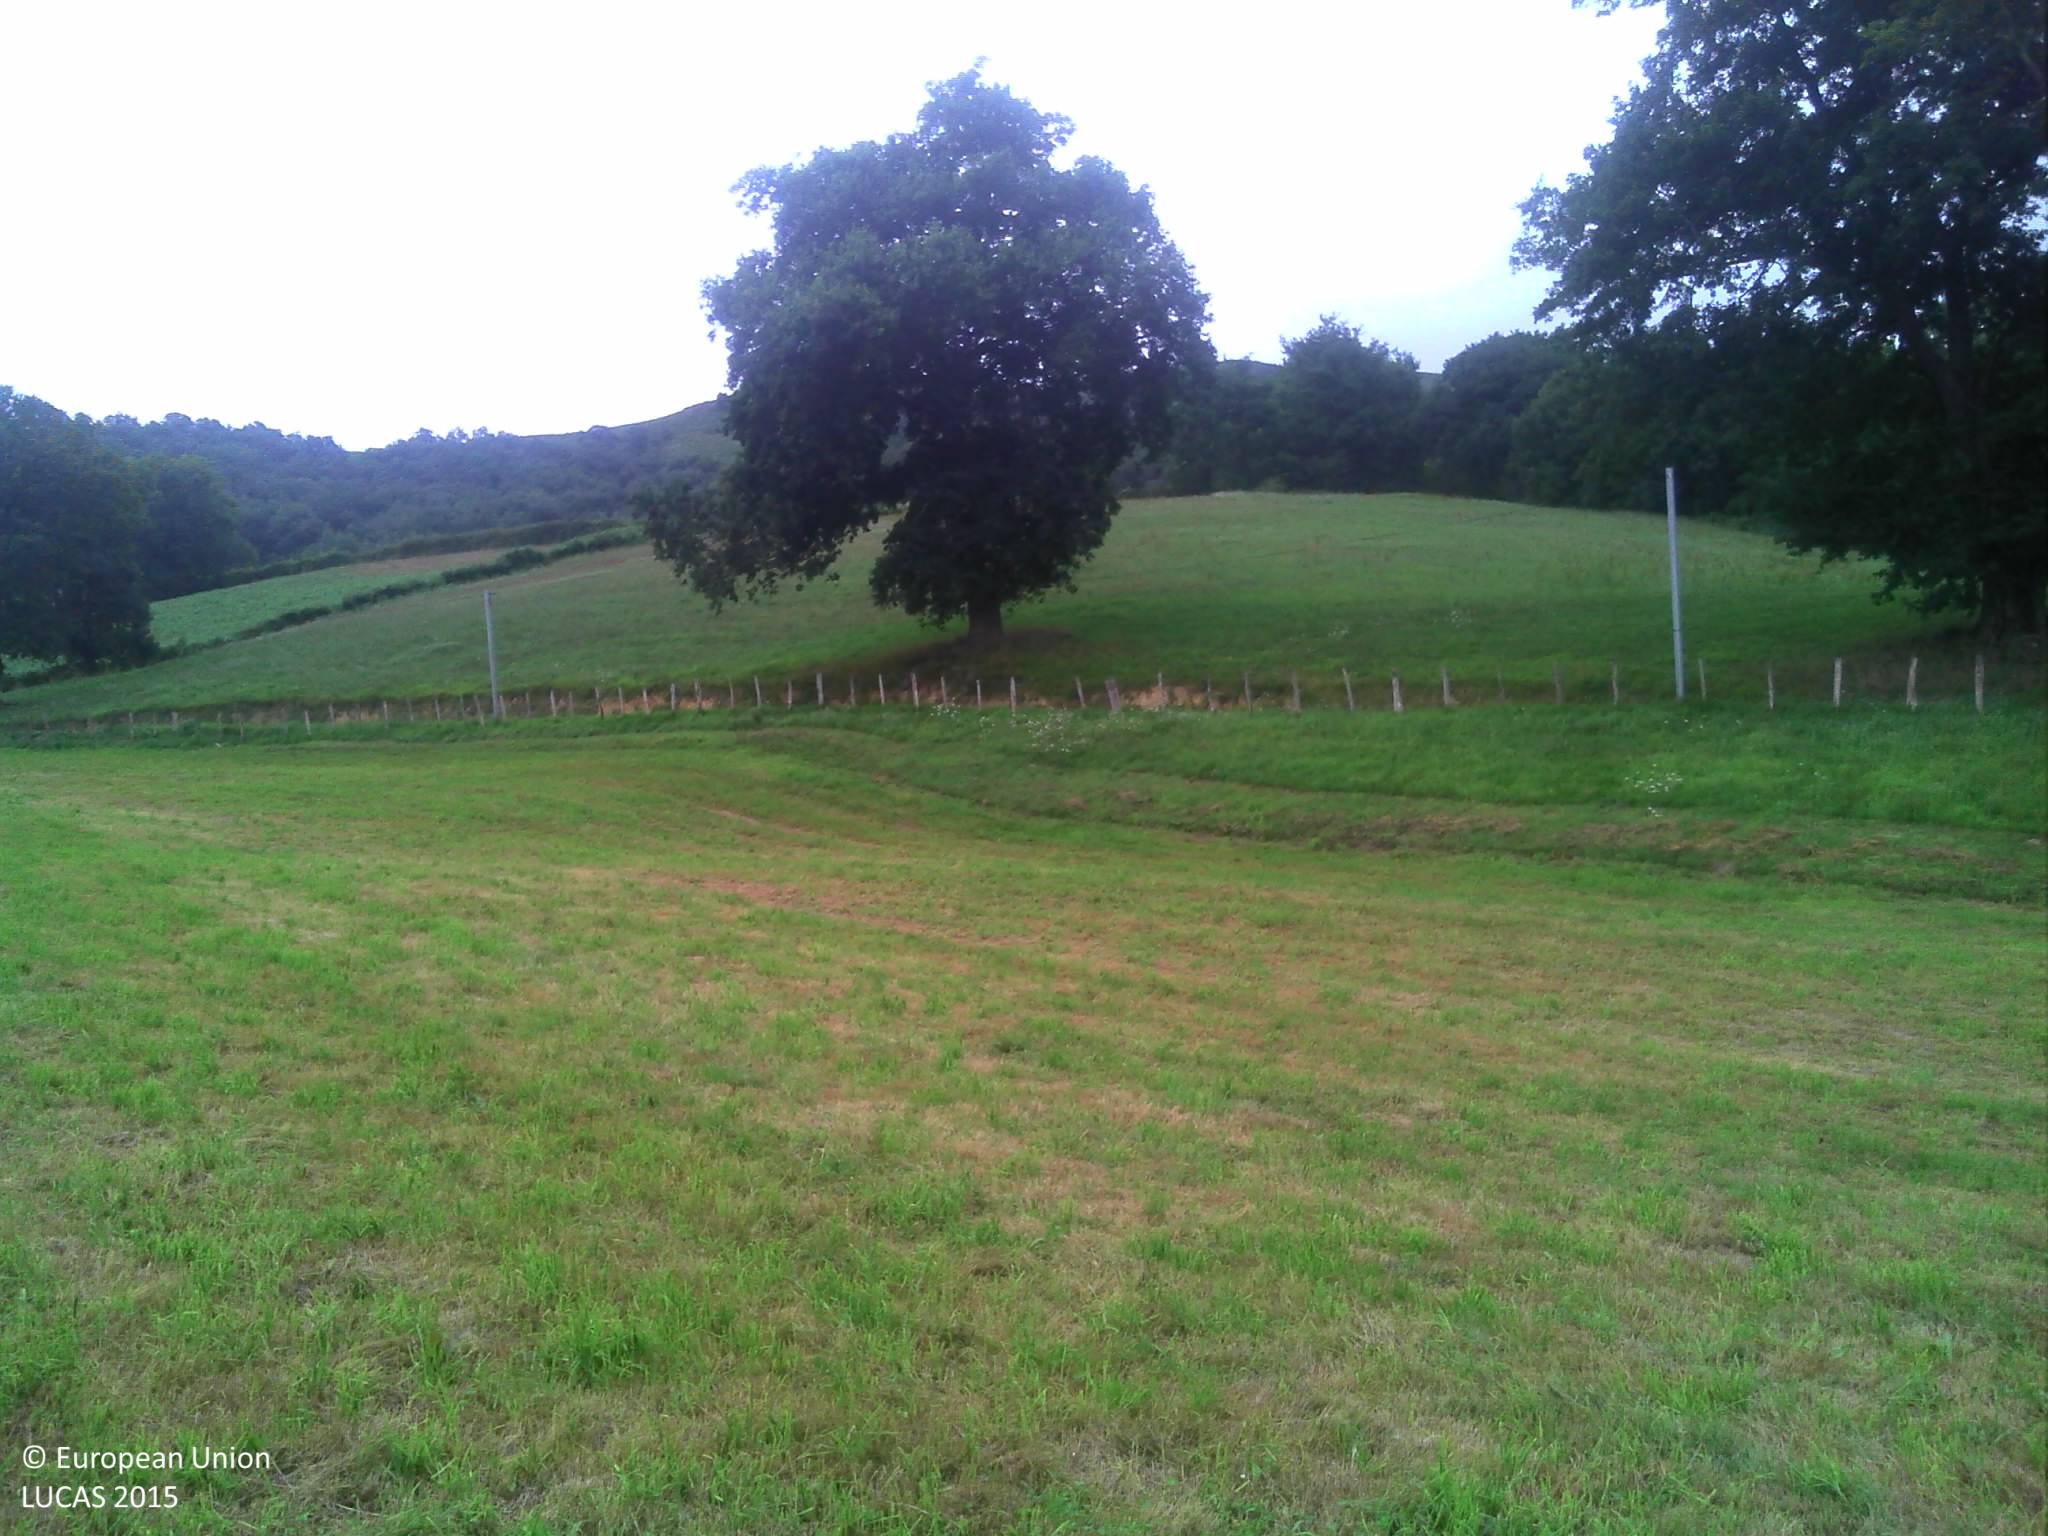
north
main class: Grassland
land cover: Grassland without tree/shrub cover
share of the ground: > 75 %
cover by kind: herbaceous plants 100 %
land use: Agriculture (excluding fallow land and kitchen gardens)
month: August
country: FR
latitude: 43.2347
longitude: -1.1819
